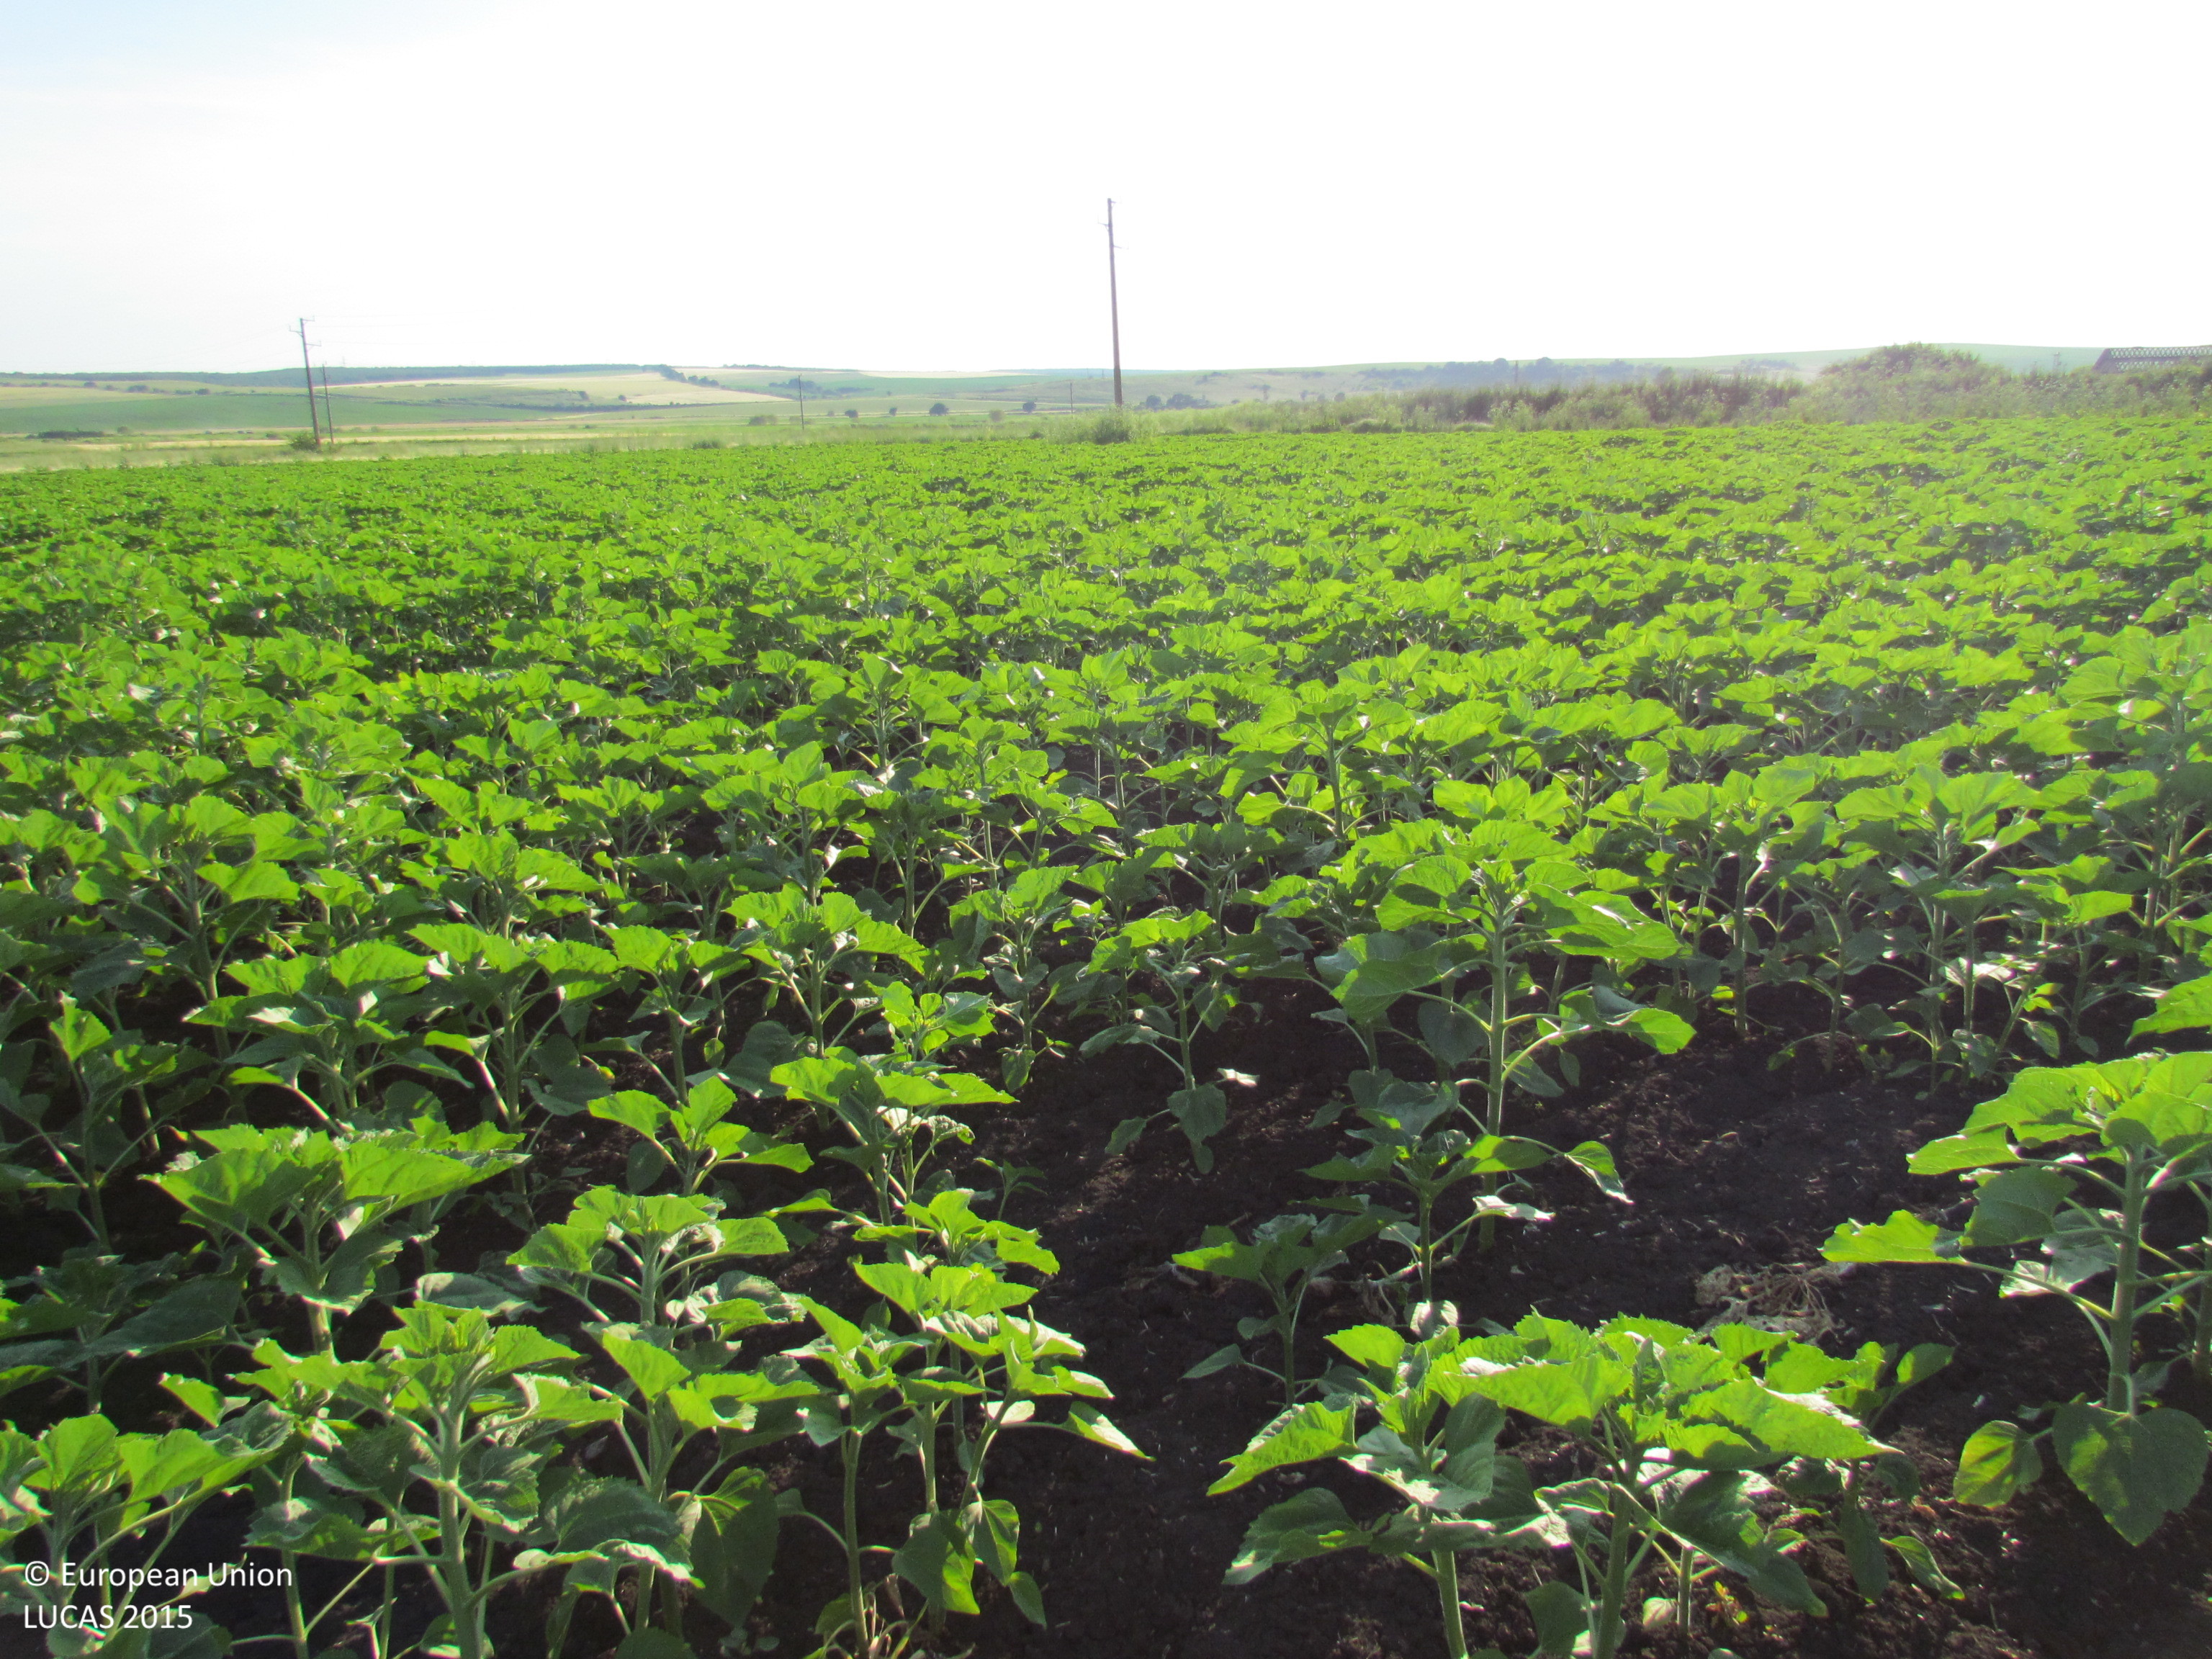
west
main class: Cropland
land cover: Sunflower
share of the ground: > 75 %
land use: Agriculture (excluding fallow land and kitchen gardens)
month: June
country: BG
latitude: 42.4600
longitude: 27.1950
